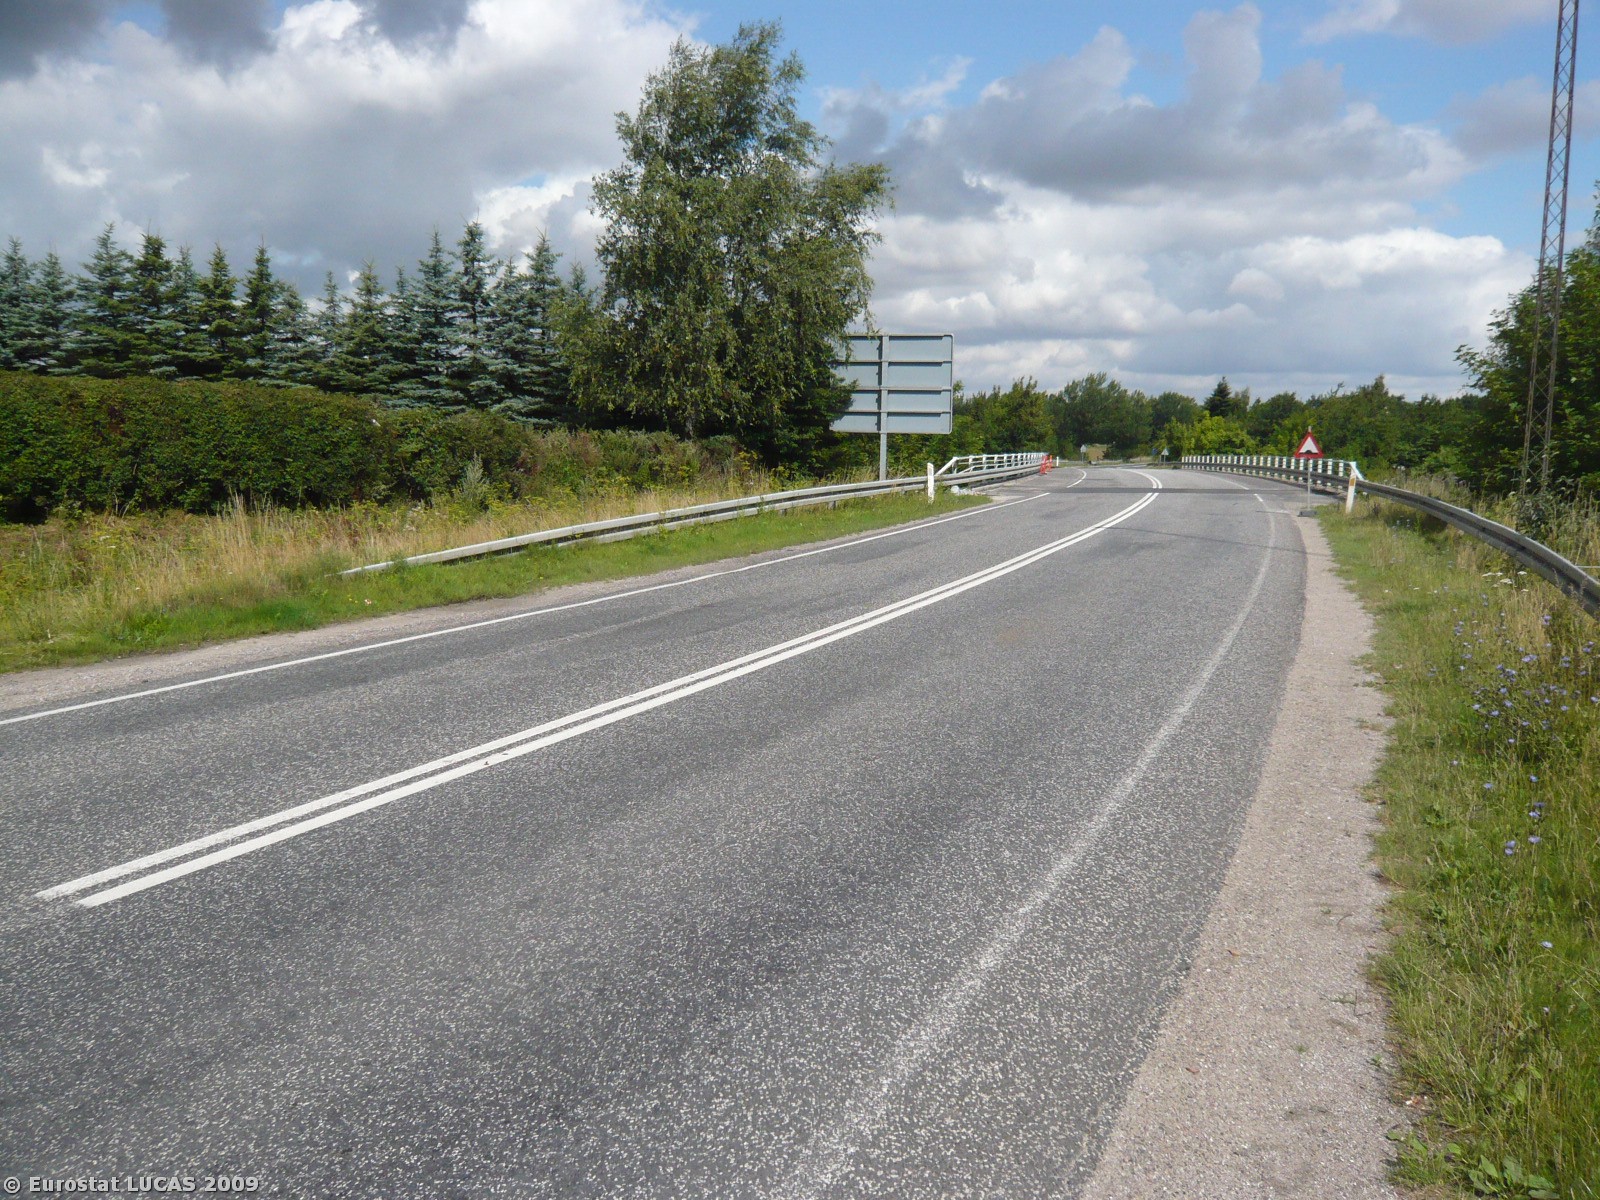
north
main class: Woodland
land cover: Broadleaved woodland
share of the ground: > 75 %
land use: Residential
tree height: > 5 m
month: July
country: DK
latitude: 55.4698
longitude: 12.0706
